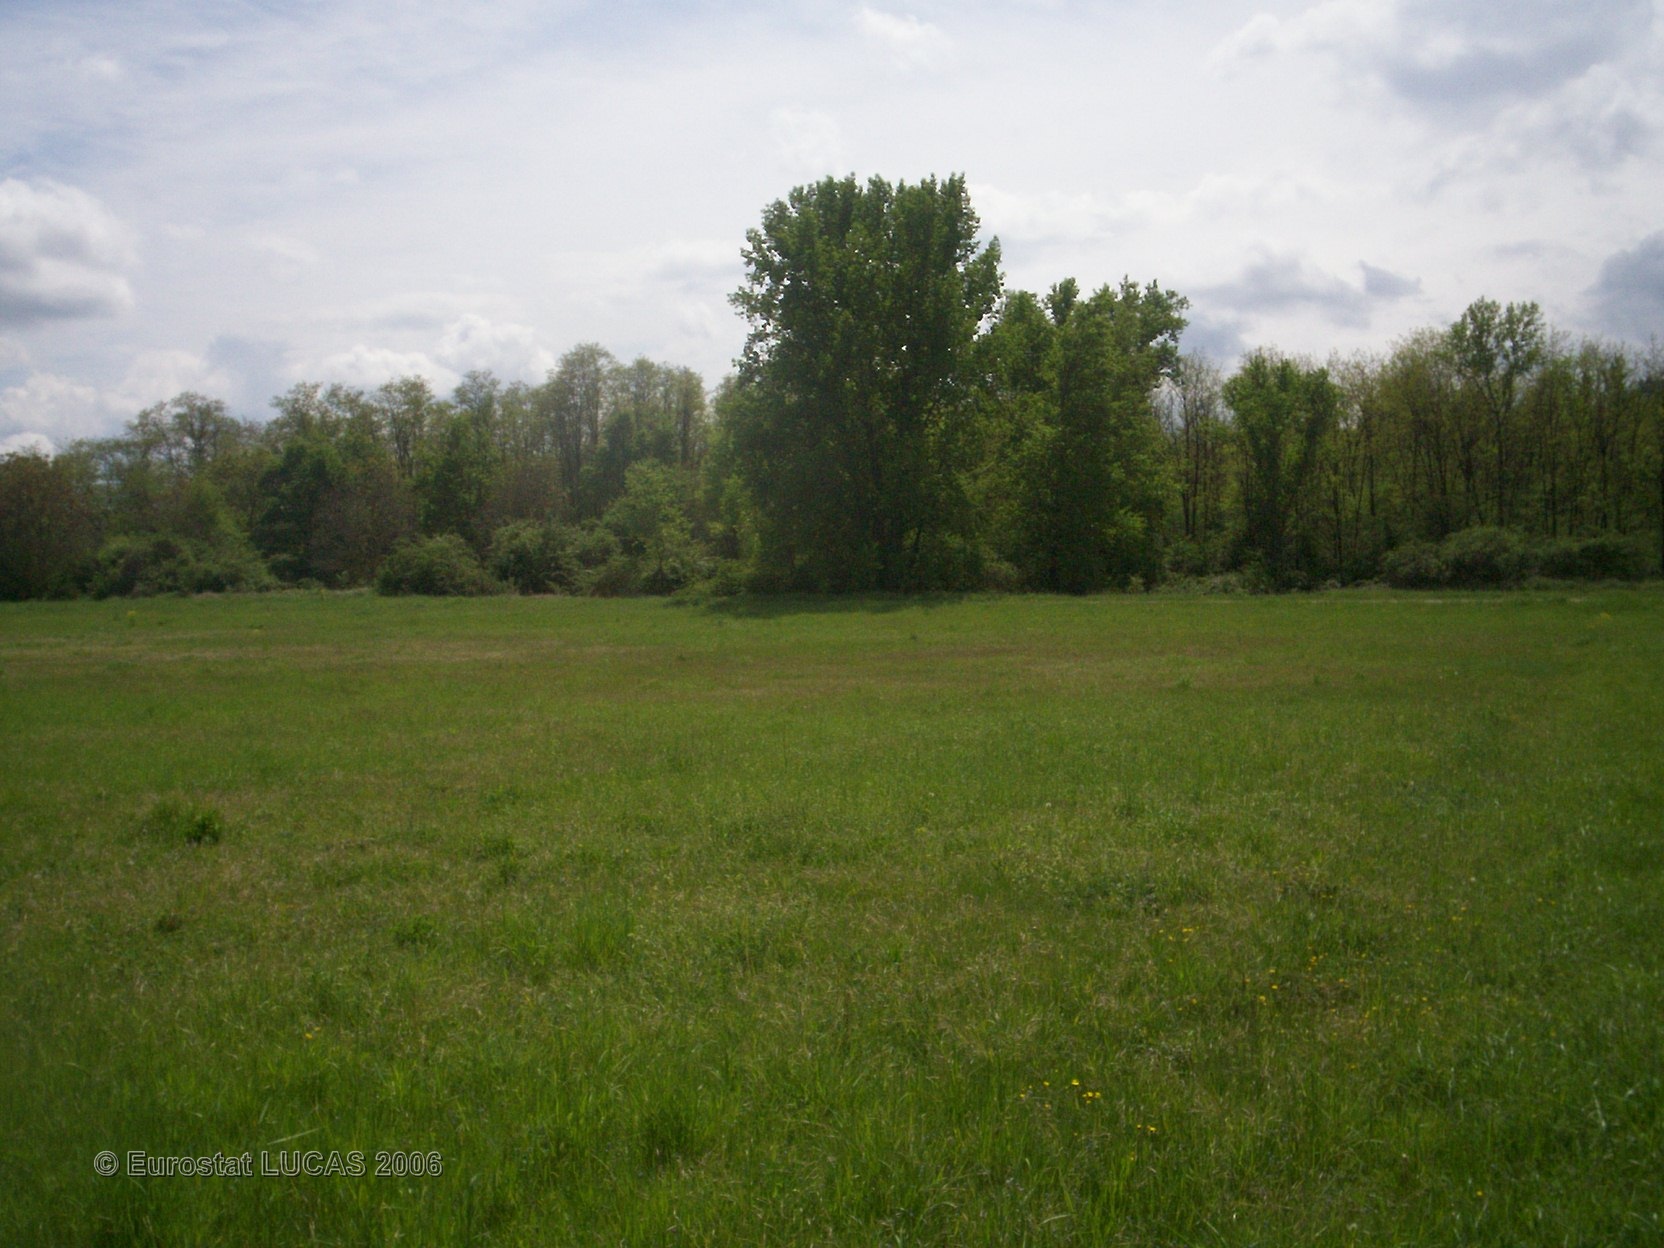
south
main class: Grassland
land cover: Grassland without tree/shrub cover
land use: Agriculture (excluding fallow land and kitchen gardens)
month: May
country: FR
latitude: 45.6834
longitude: 3.2084
